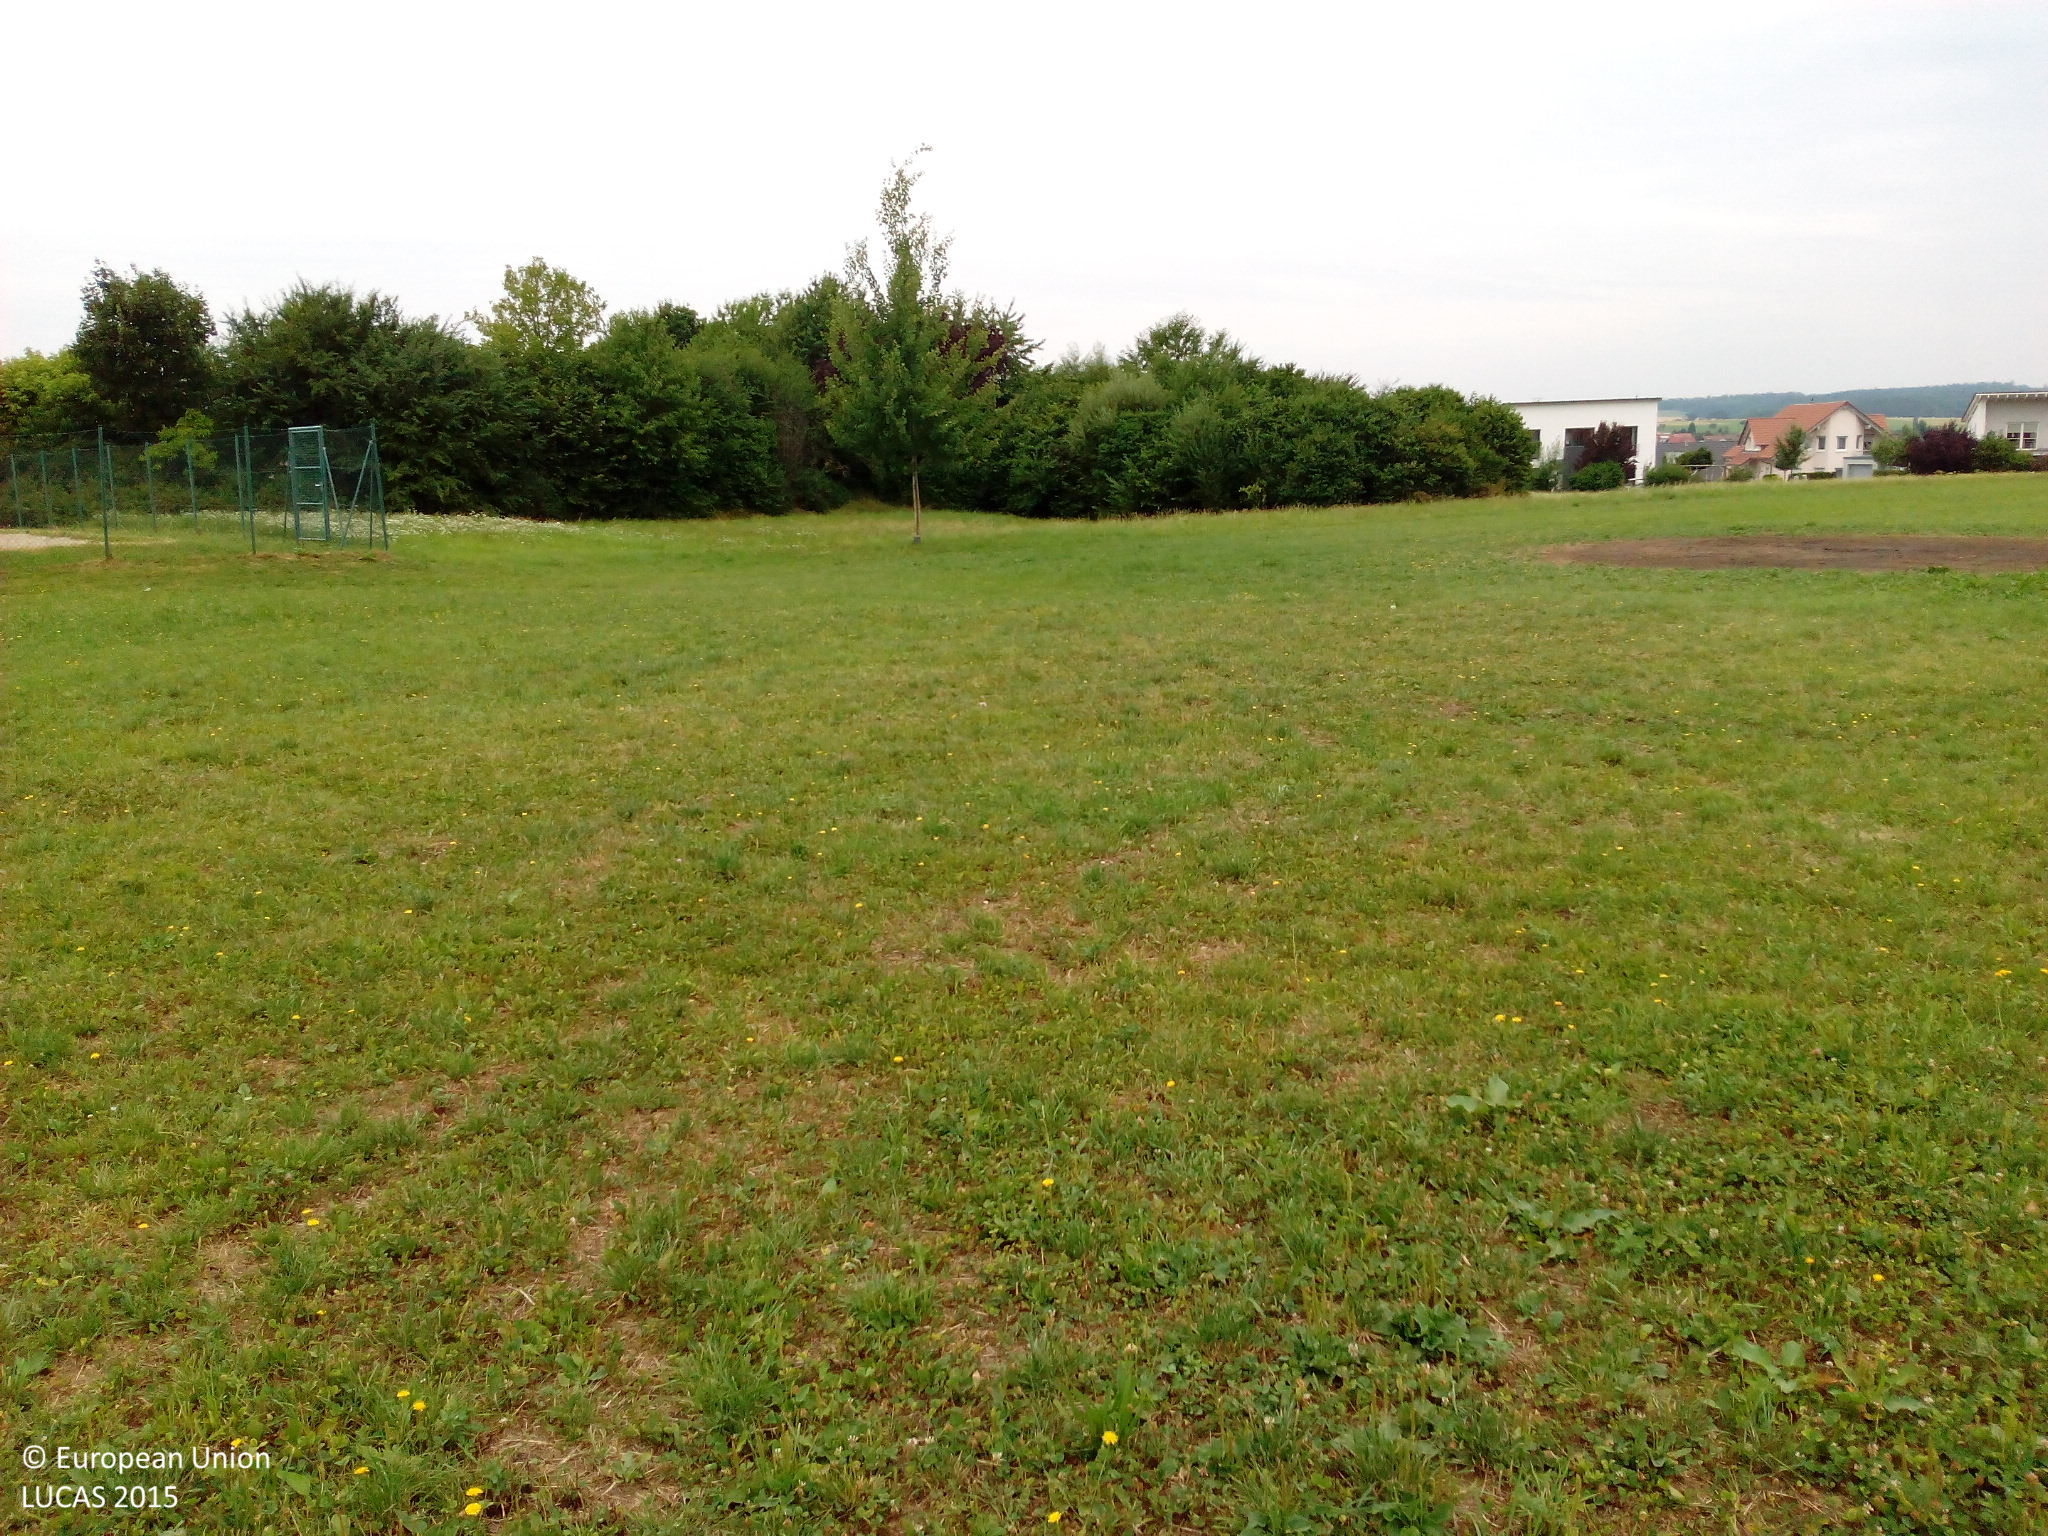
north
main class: Grassland
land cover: Grassland without tree/shrub cover
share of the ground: > 75 %
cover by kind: herbaceous plants 90 %, unconsolidated bare surface 10 %
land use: Amenities, museums, leisure
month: July
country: DE
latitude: 48.8173
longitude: 9.9592
